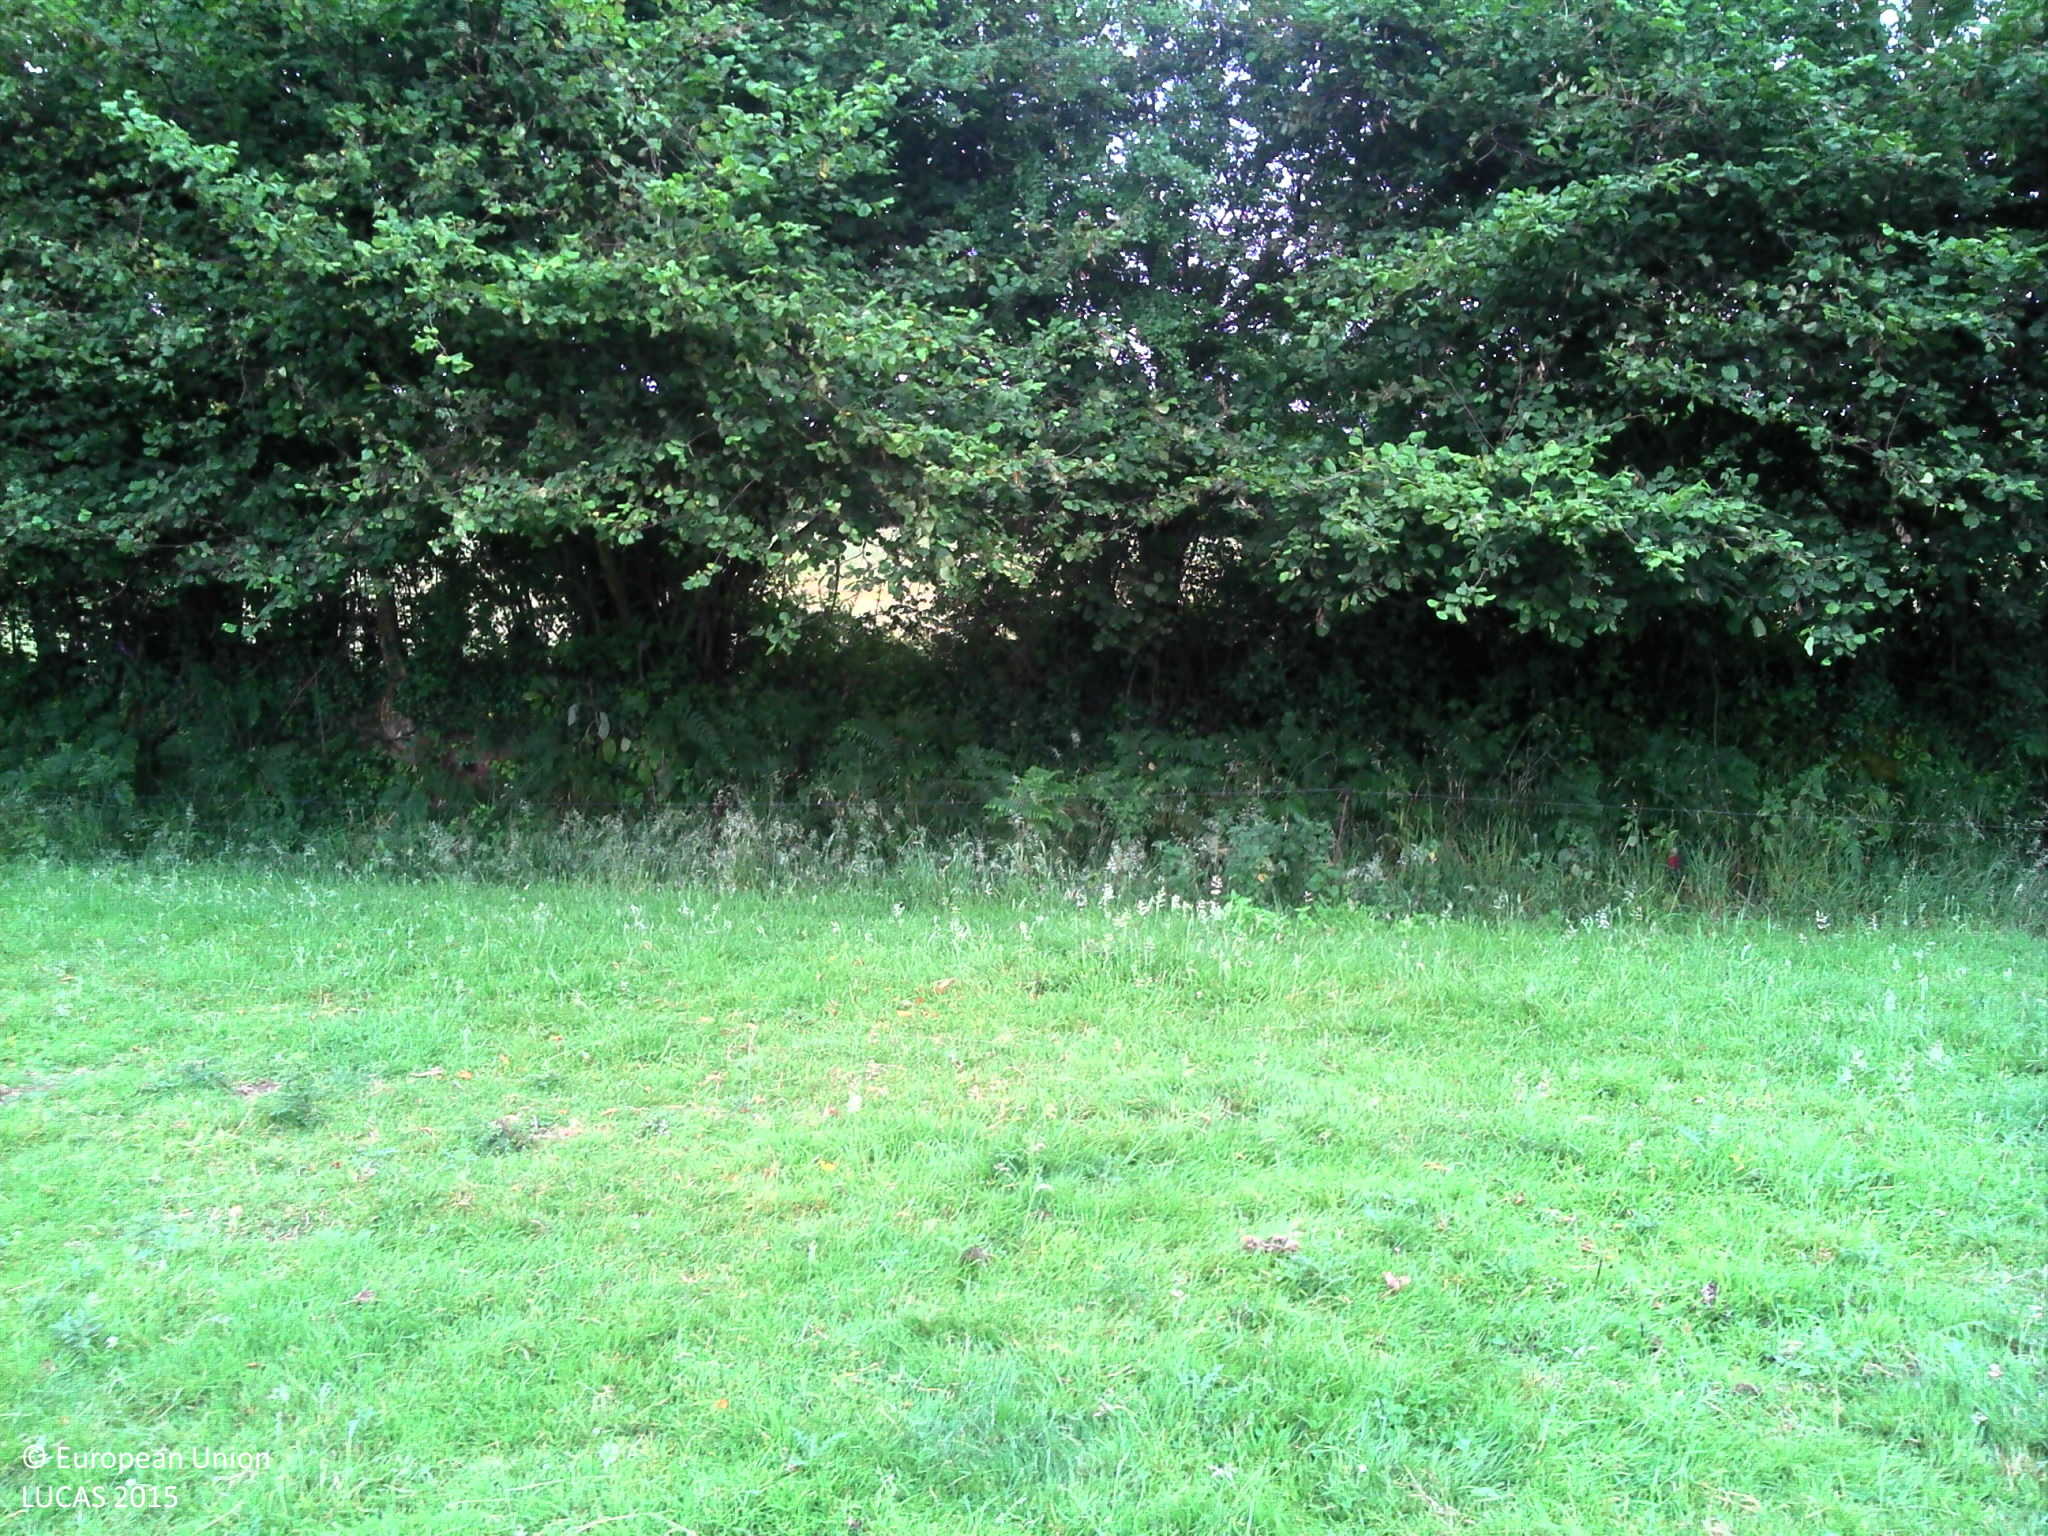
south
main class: Grassland
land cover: Grassland without tree/shrub cover
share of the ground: > 75 %
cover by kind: herbaceous plants 100 %
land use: Agriculture (excluding fallow land and kitchen gardens)
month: July
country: FR
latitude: 49.1043
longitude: -1.3748
